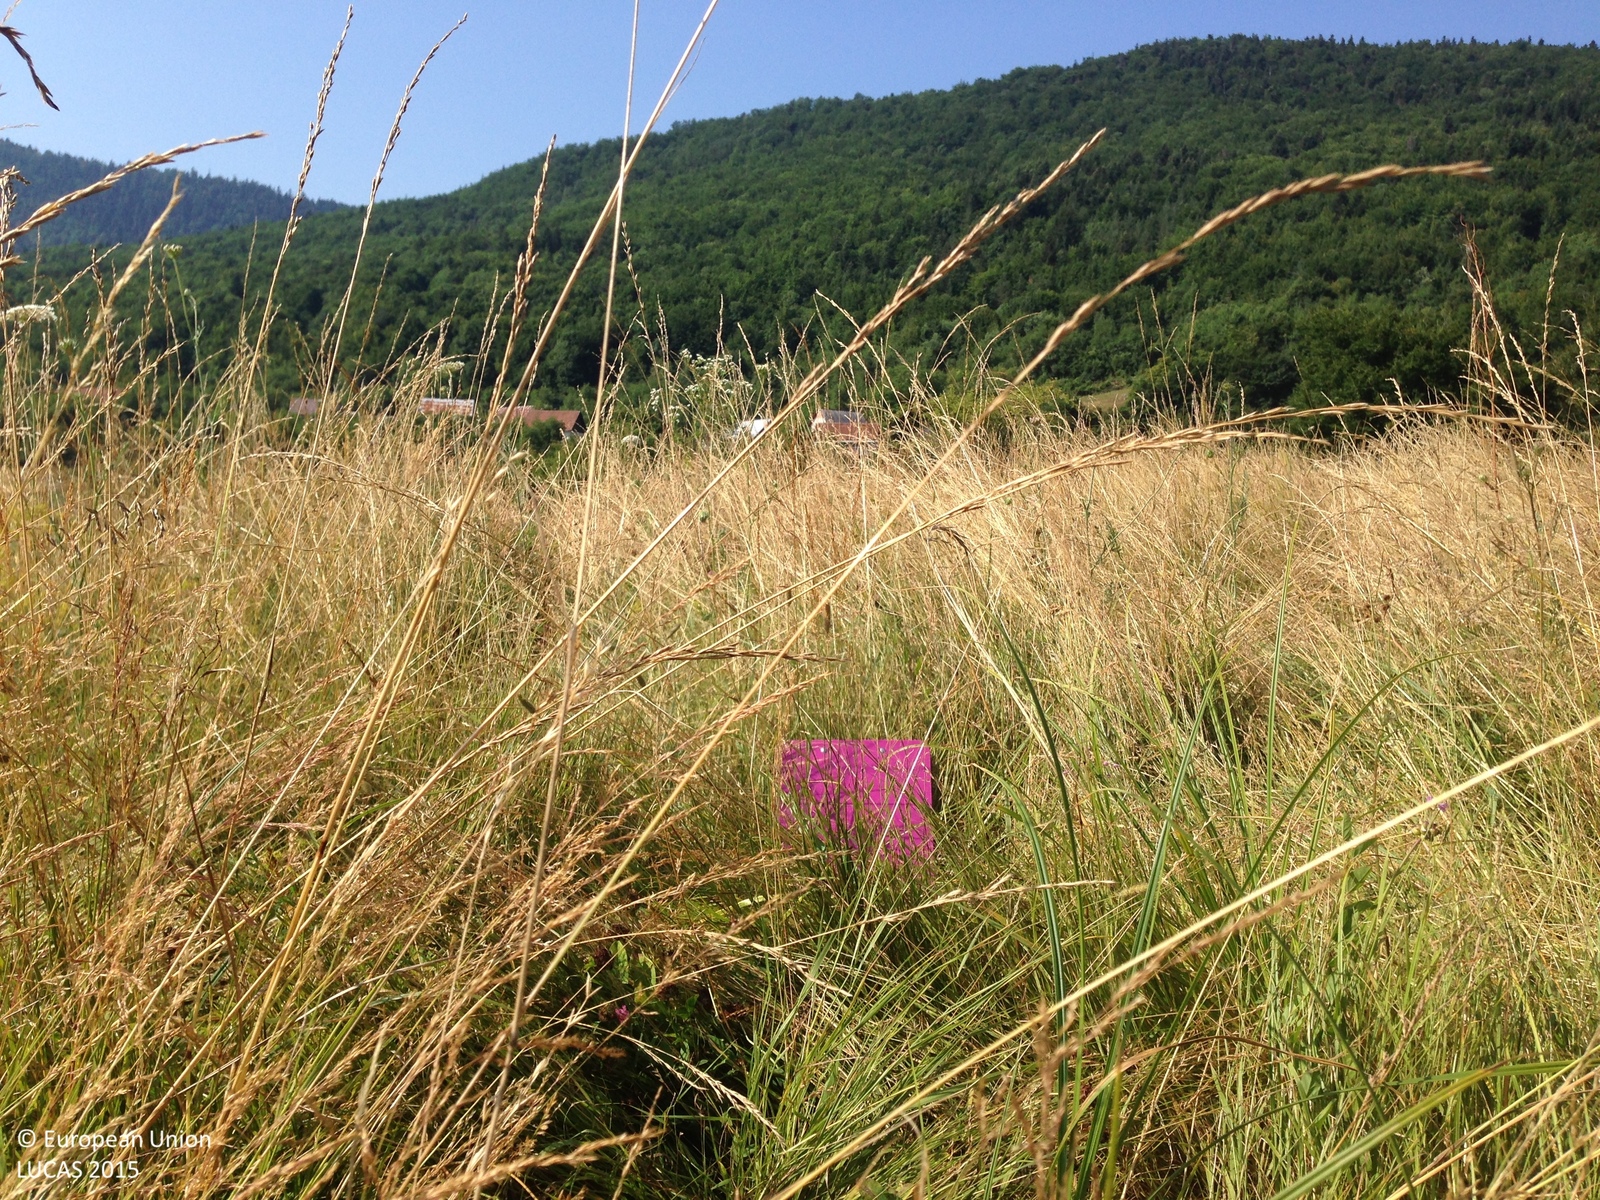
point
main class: Grassland
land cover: Grassland without tree/shrub cover
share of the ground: > 75 %
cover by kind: herbaceous plants 95 %, shrubs 5 %
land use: Agriculture (excluding fallow land and kitchen gardens)
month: July
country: HR
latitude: 44.7629
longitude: 15.1864
